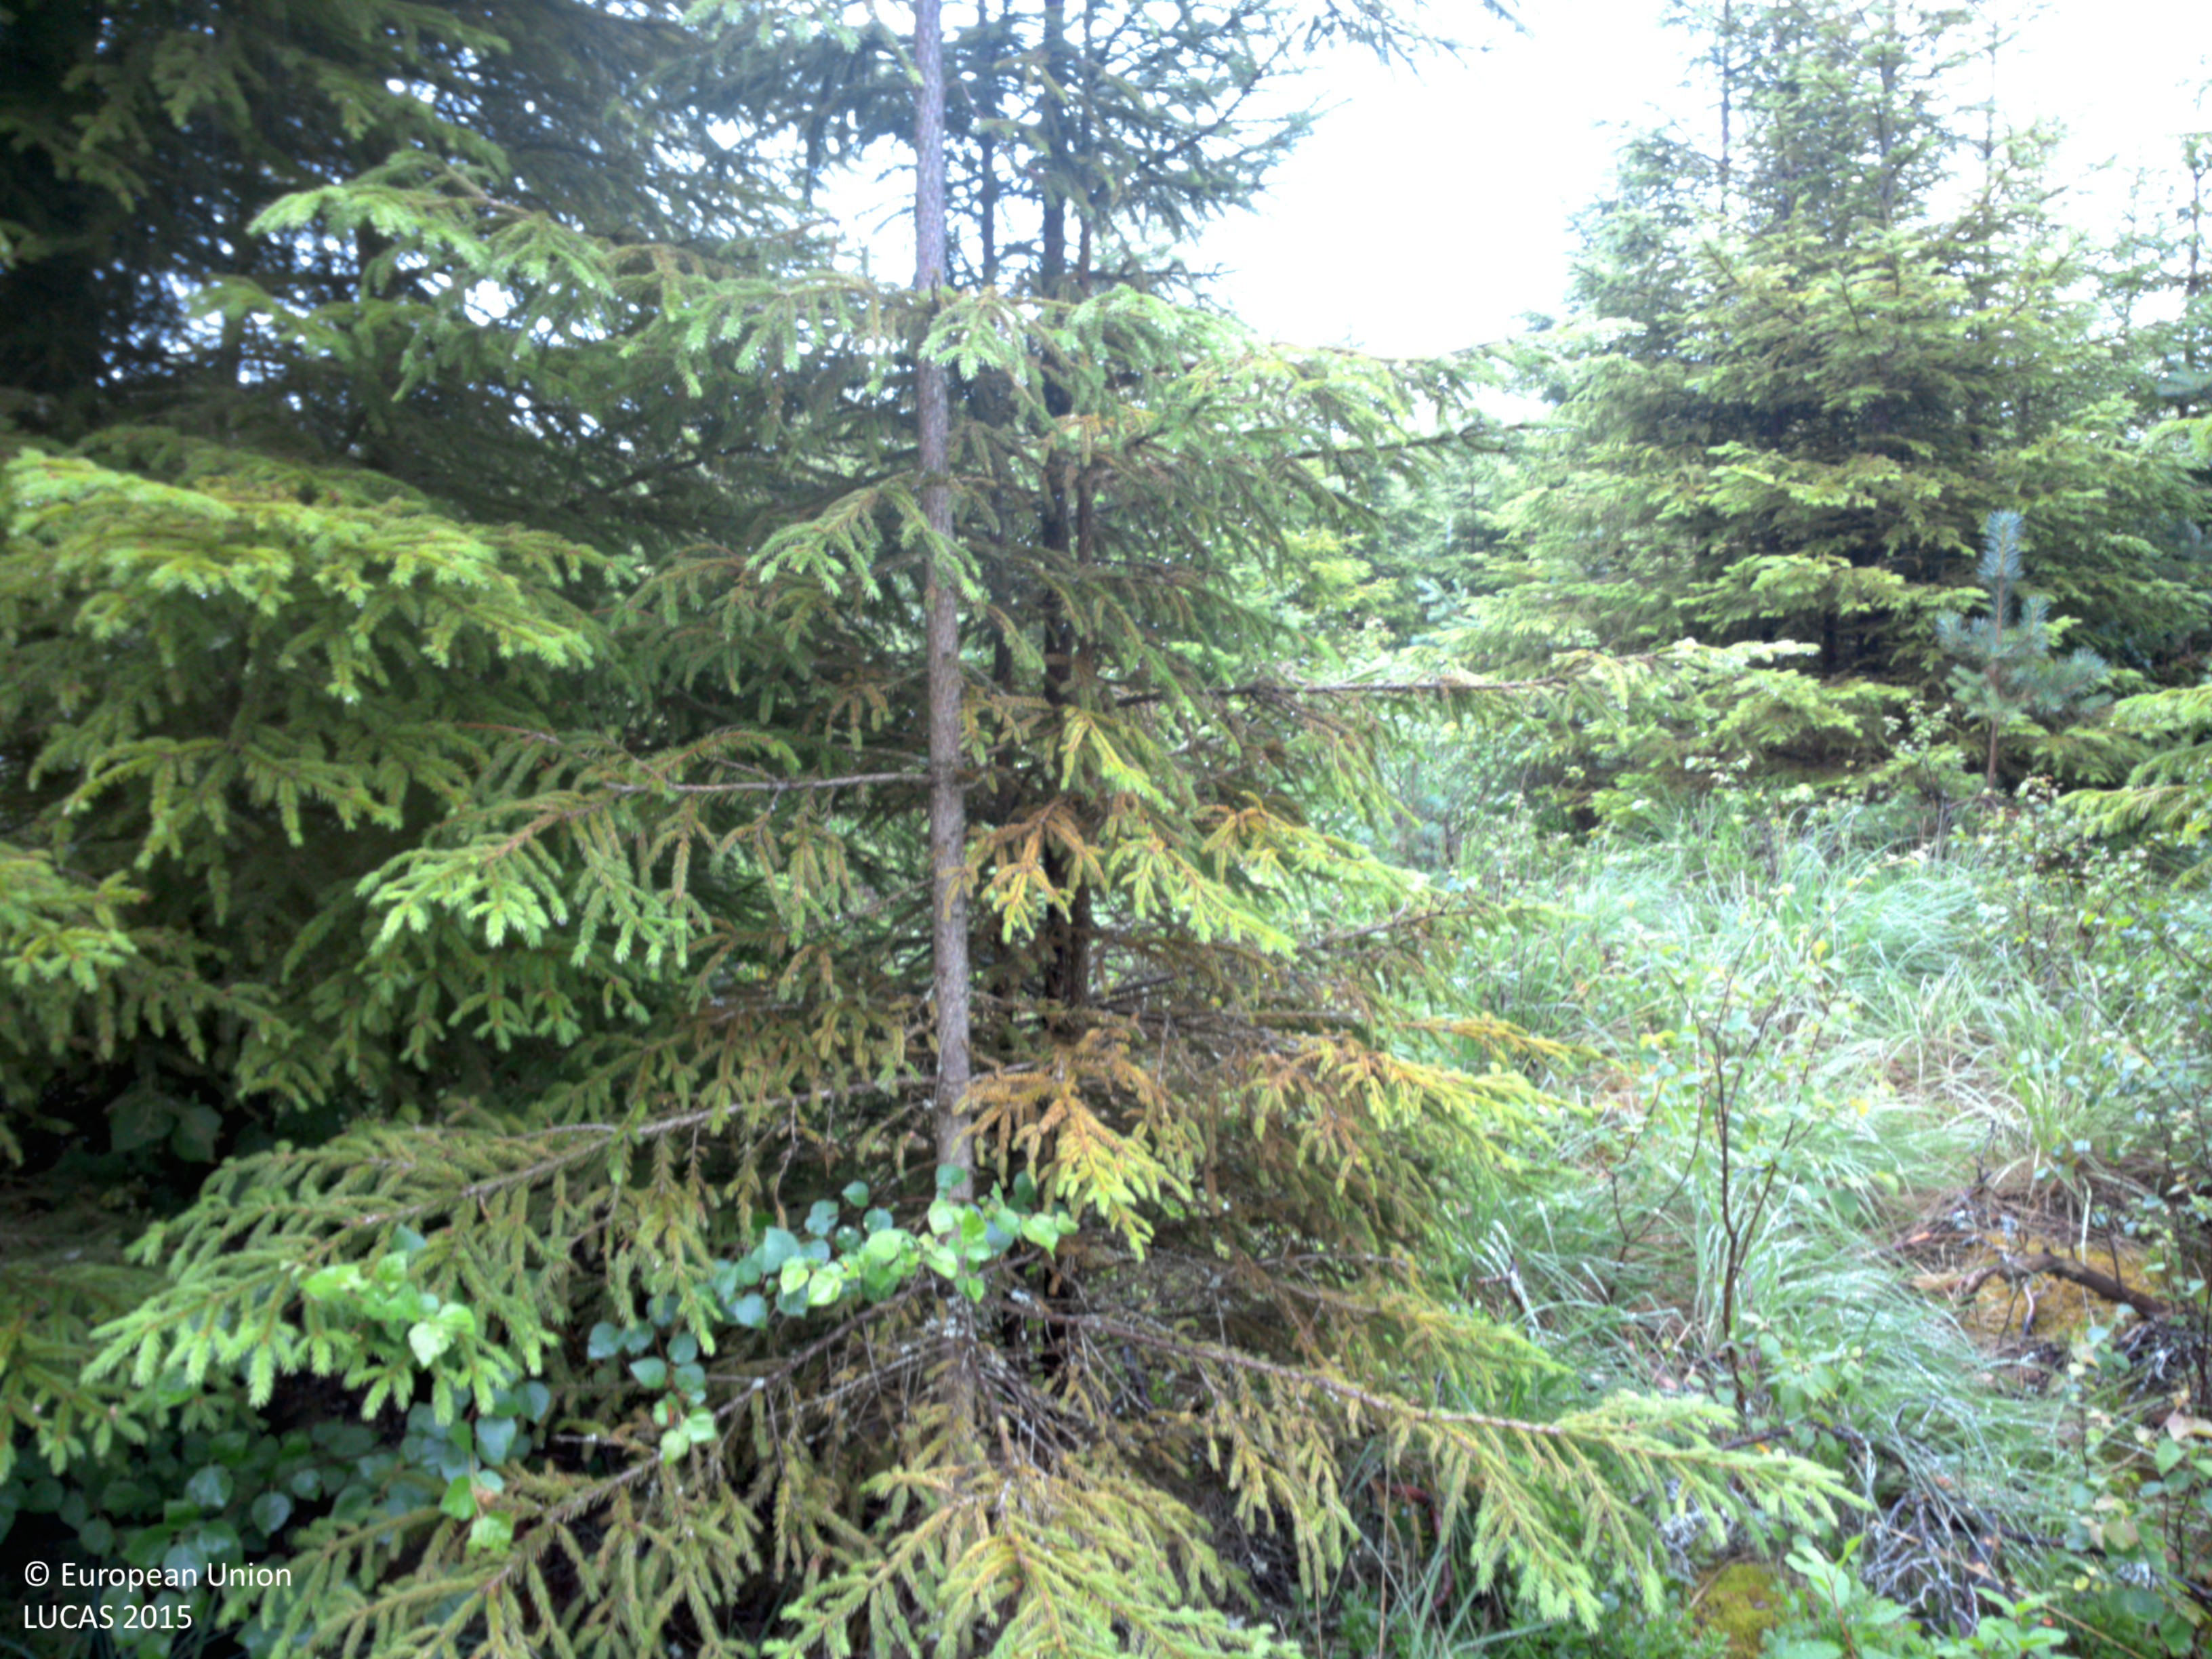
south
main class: Woodland
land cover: Spruce dominated mixed woodland
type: boreal forest
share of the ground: 50 - 75 %
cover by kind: coniferous forest trees 40 %, shrubs 40 %, broadleaved forest trees 20 %
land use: Forestry
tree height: > 5 m
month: July
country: SE
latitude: 58.6597
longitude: 11.5996
